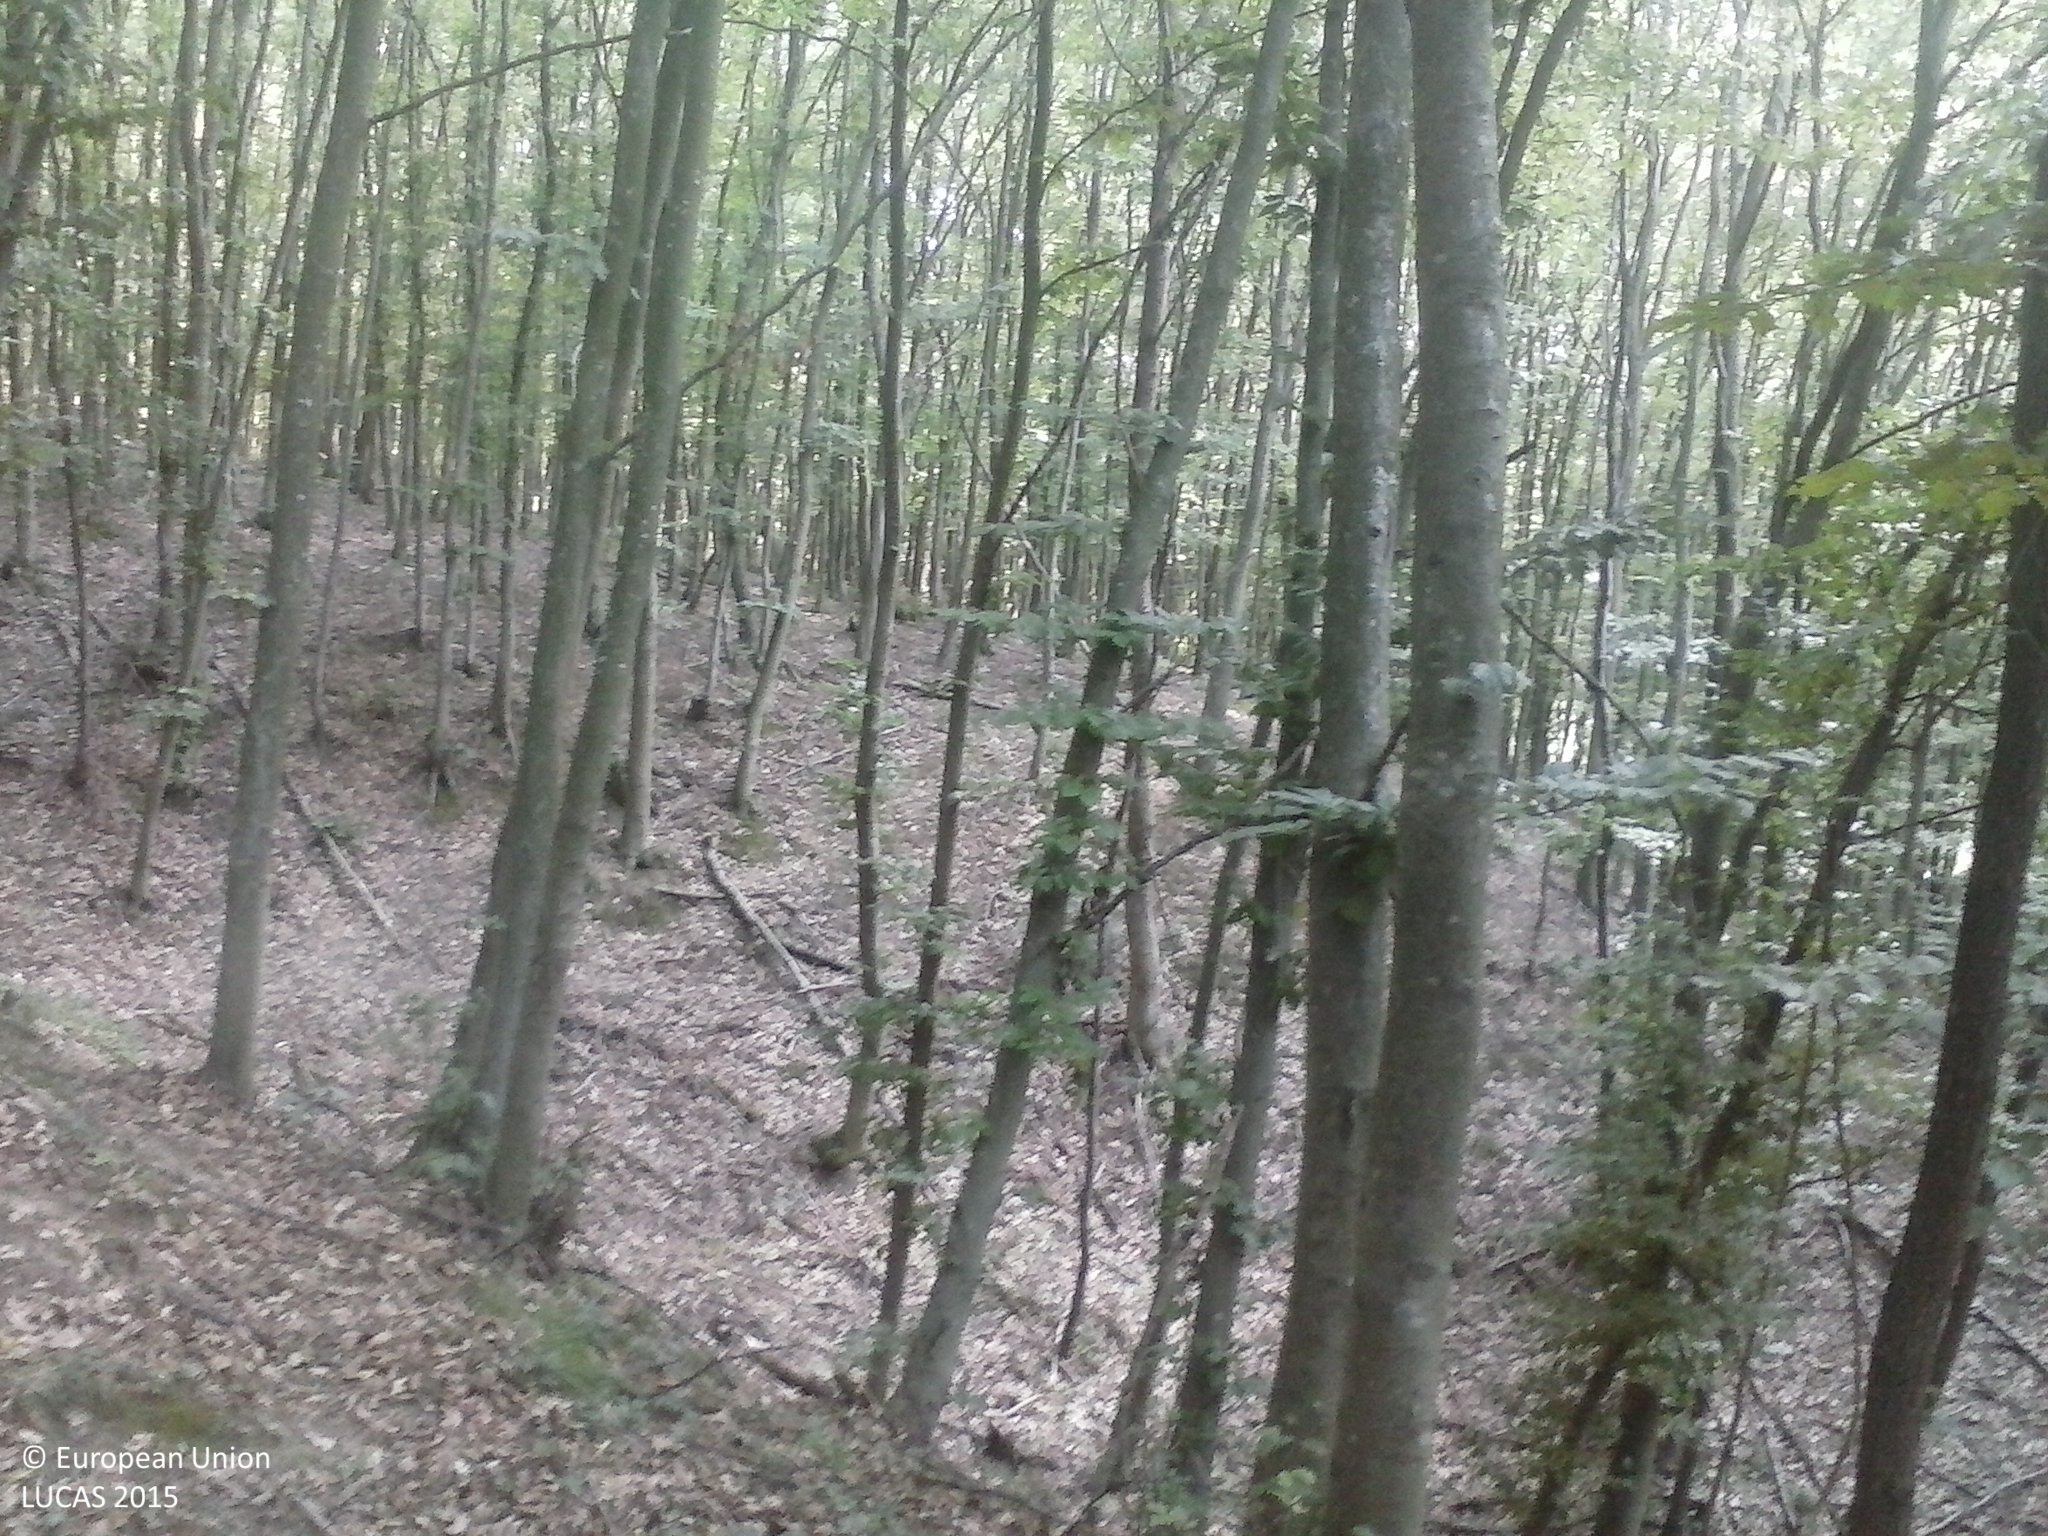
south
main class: Woodland
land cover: Broadleaved woodland
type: beech forest
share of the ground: > 75 %
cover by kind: broadleaved forest trees 100 %
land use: Forestry
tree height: > 5 m
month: August
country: HU
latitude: 46.1198
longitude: 17.8082
